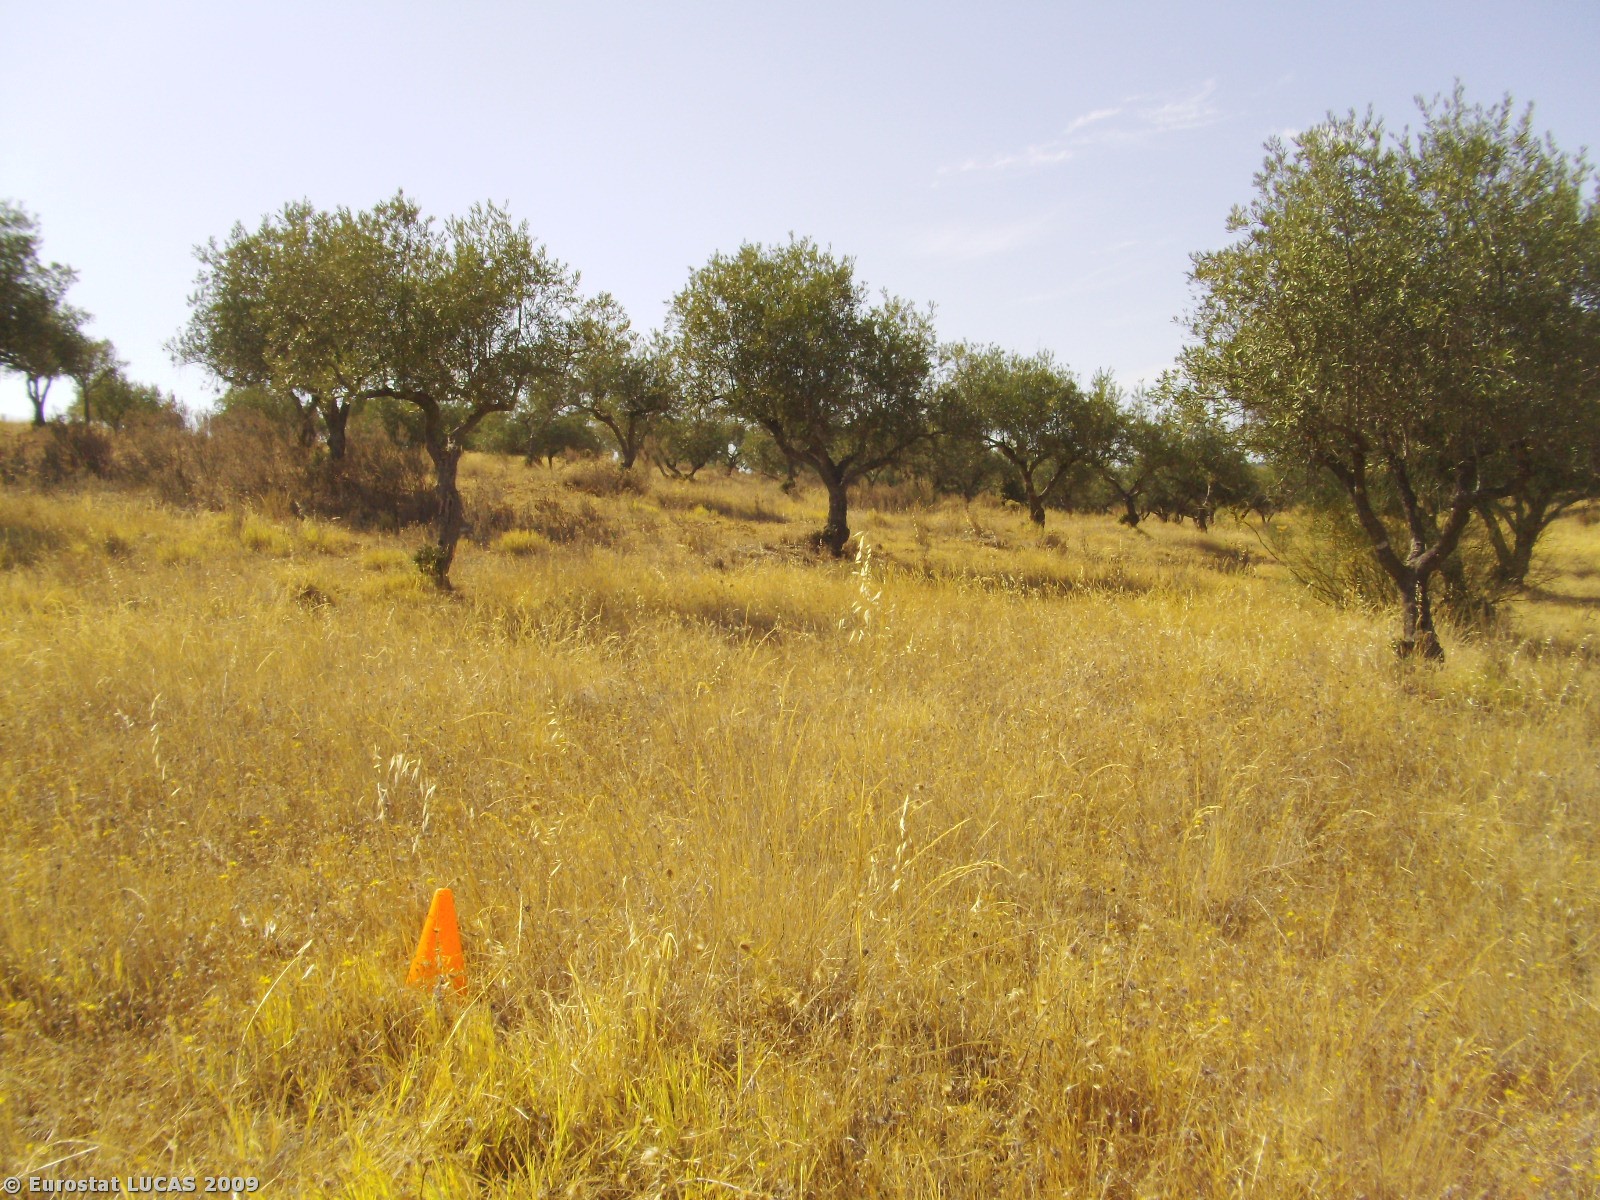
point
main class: Cropland
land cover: Olive groves
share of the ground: 25 - 50 %
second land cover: Spontaneously vegetated surfaces
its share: 25 - 50 %
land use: Agriculture (excluding fallow land and kitchen gardens)
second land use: Fallow land
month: August
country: PT
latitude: 38.1786
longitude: -7.6168
